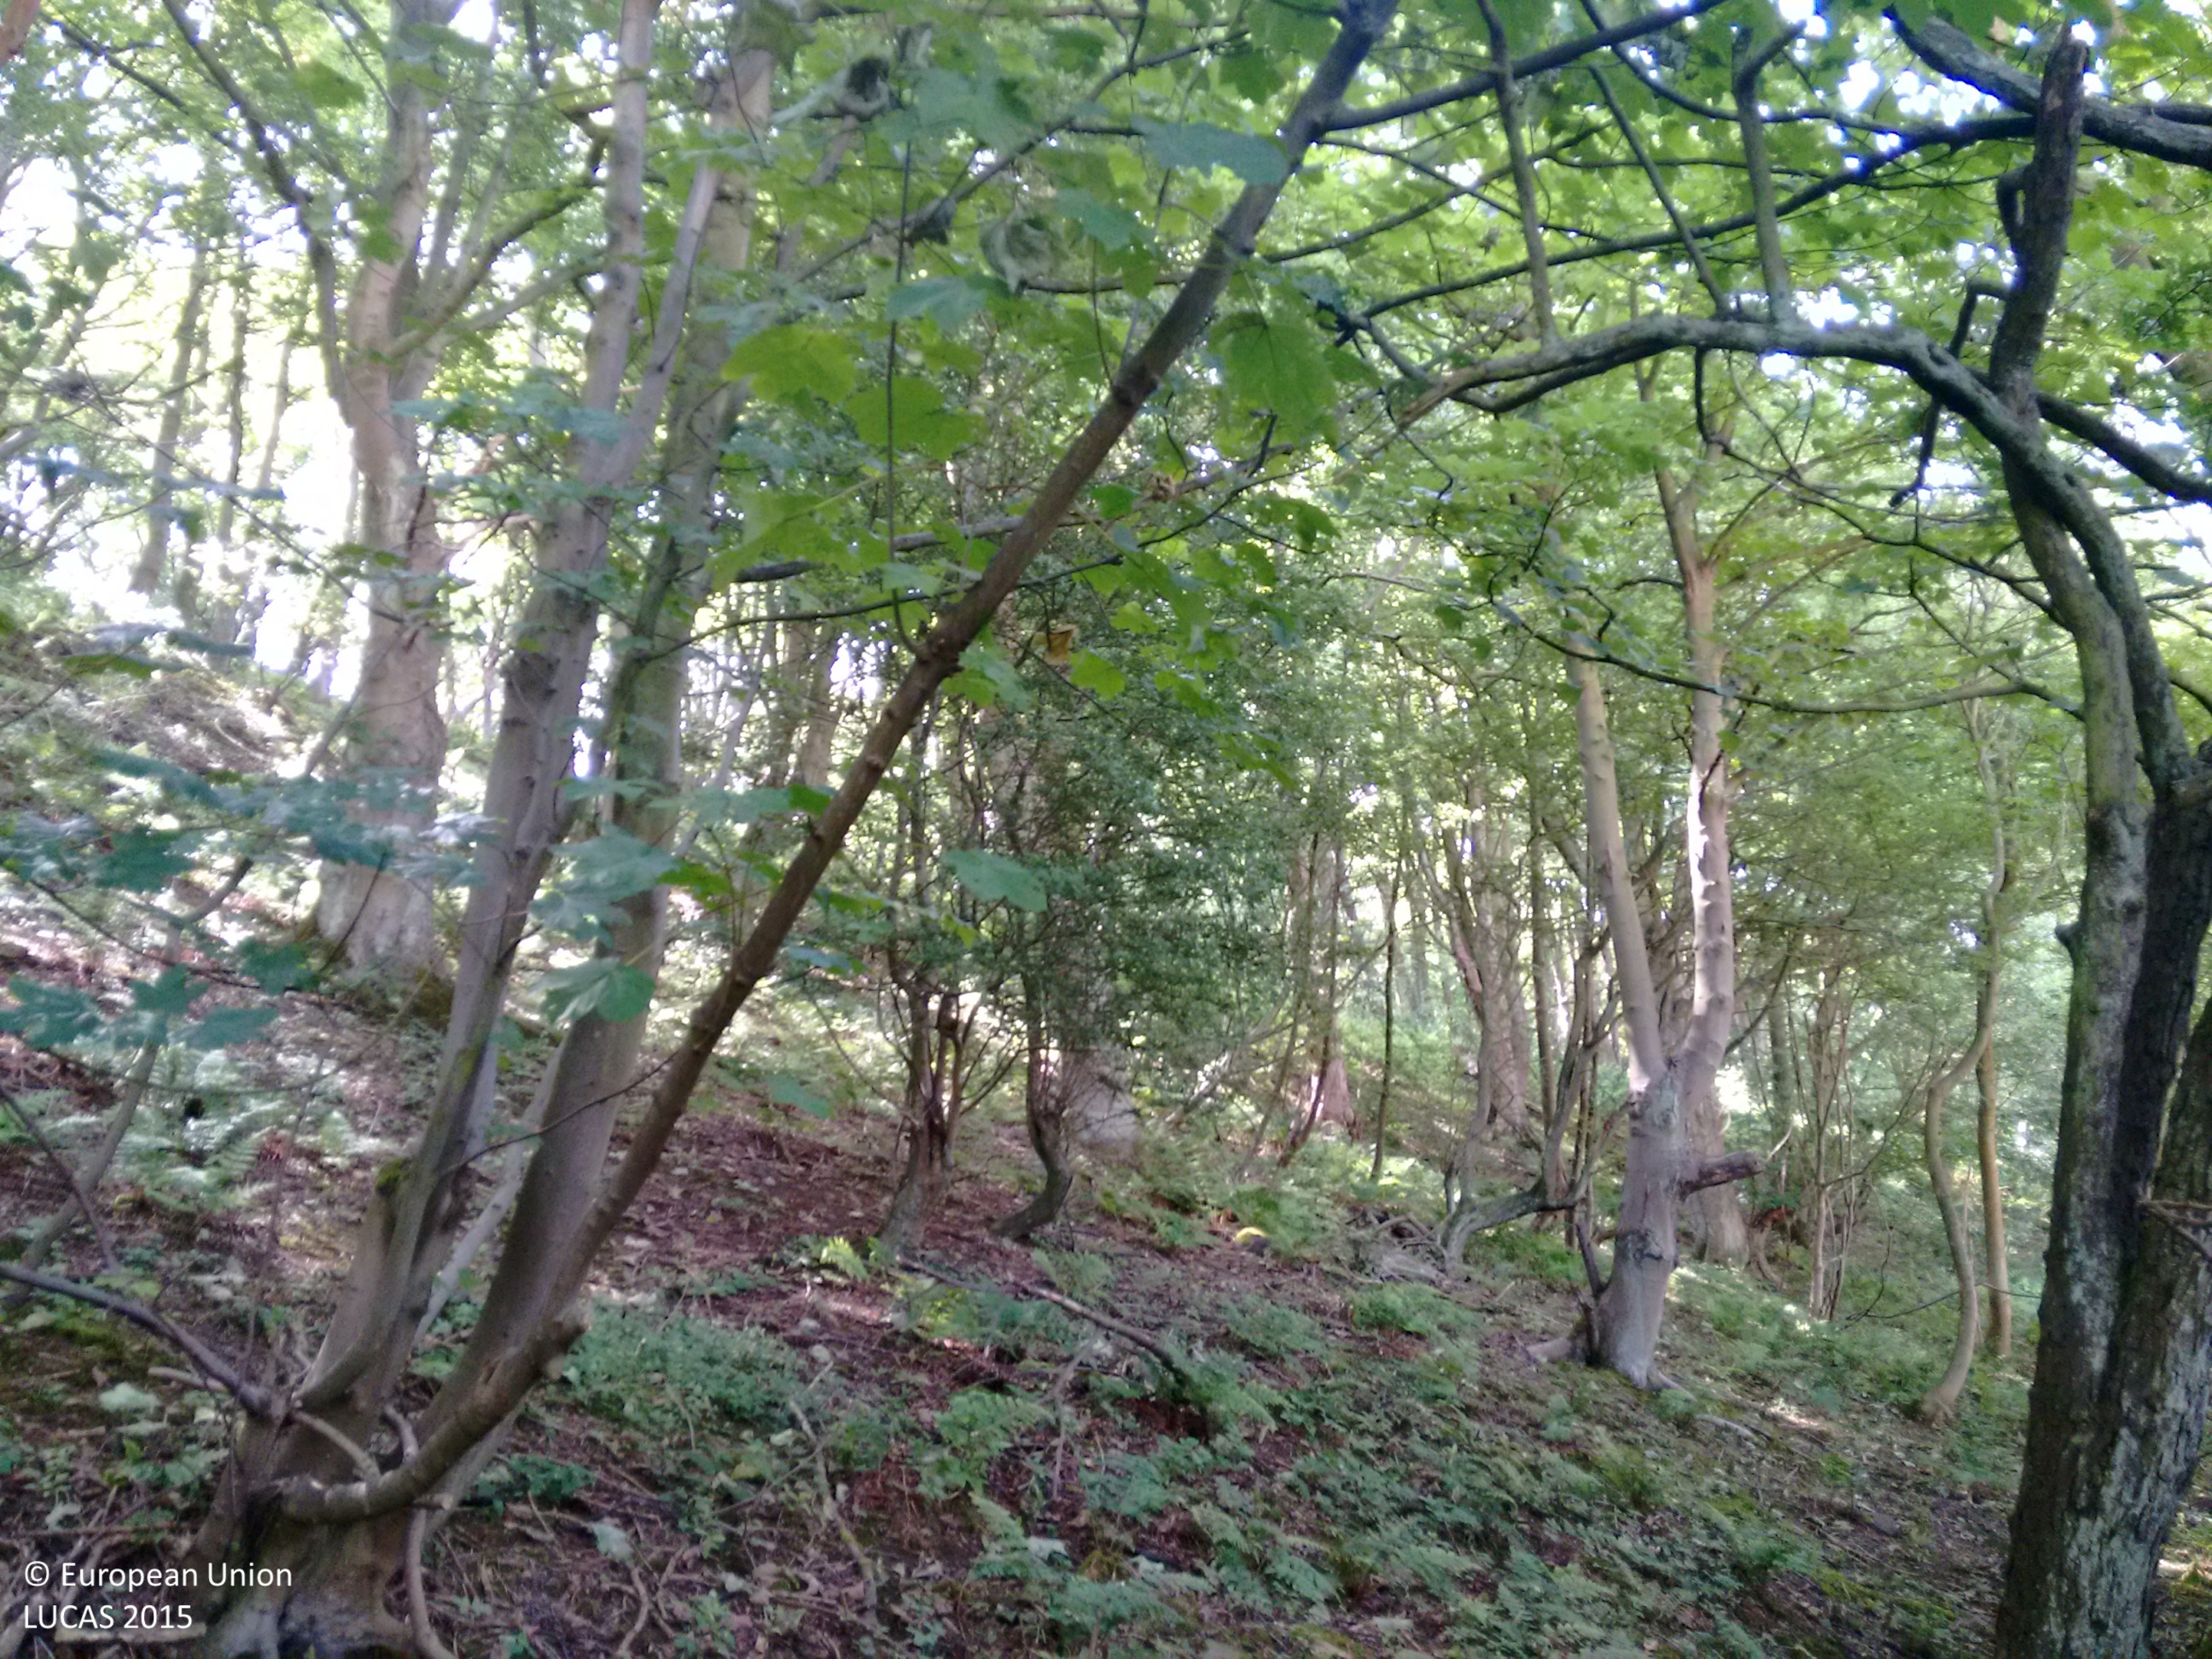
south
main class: Woodland
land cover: Broadleaved woodland
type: mesophytic deciduous forest
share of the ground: > 75 %
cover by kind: broadleaved forest trees 100 %
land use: Amenities, museums, leisure
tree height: > 5 m
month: July
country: GB
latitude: 56.0307
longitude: -3.3780
